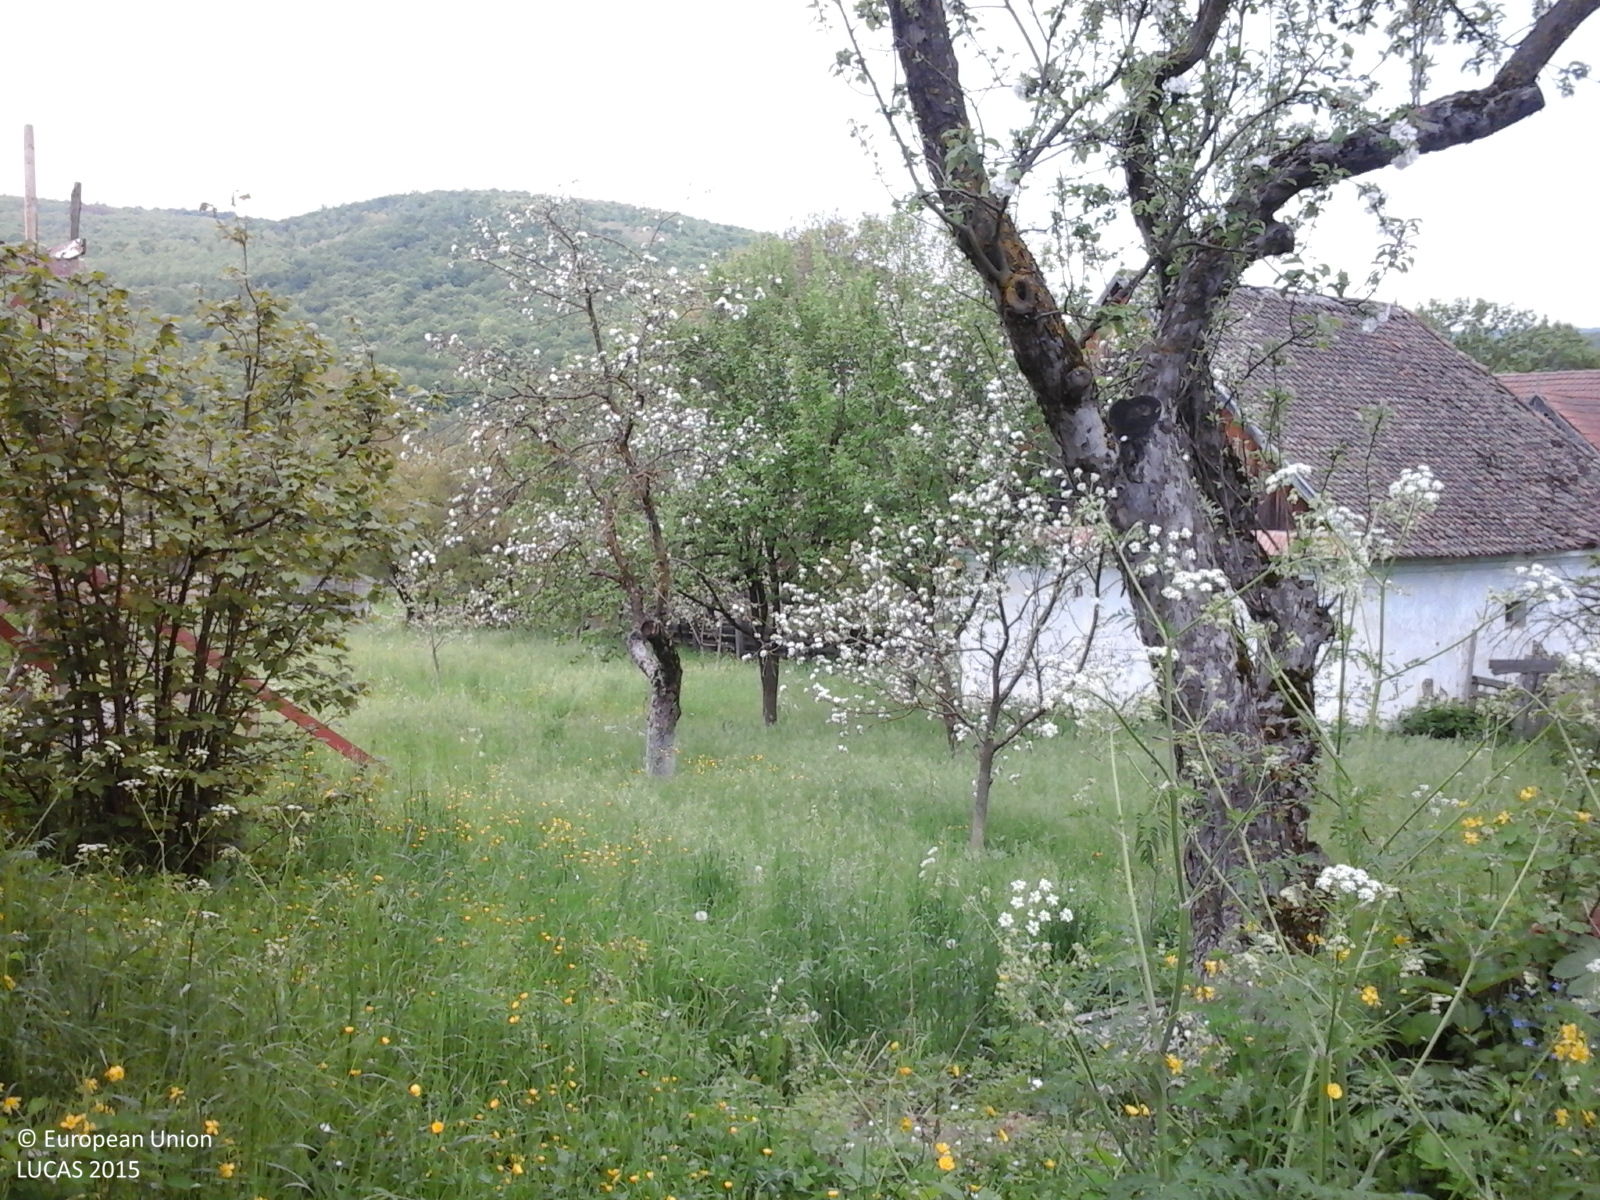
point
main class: Cropland
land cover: Apple fruit
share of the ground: 25 - 50 %
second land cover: Grassland without tree/shrub cover
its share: > 75 %
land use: Kitchen garden
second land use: Residential
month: May
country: RO
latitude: 45.9799
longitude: 26.0065
